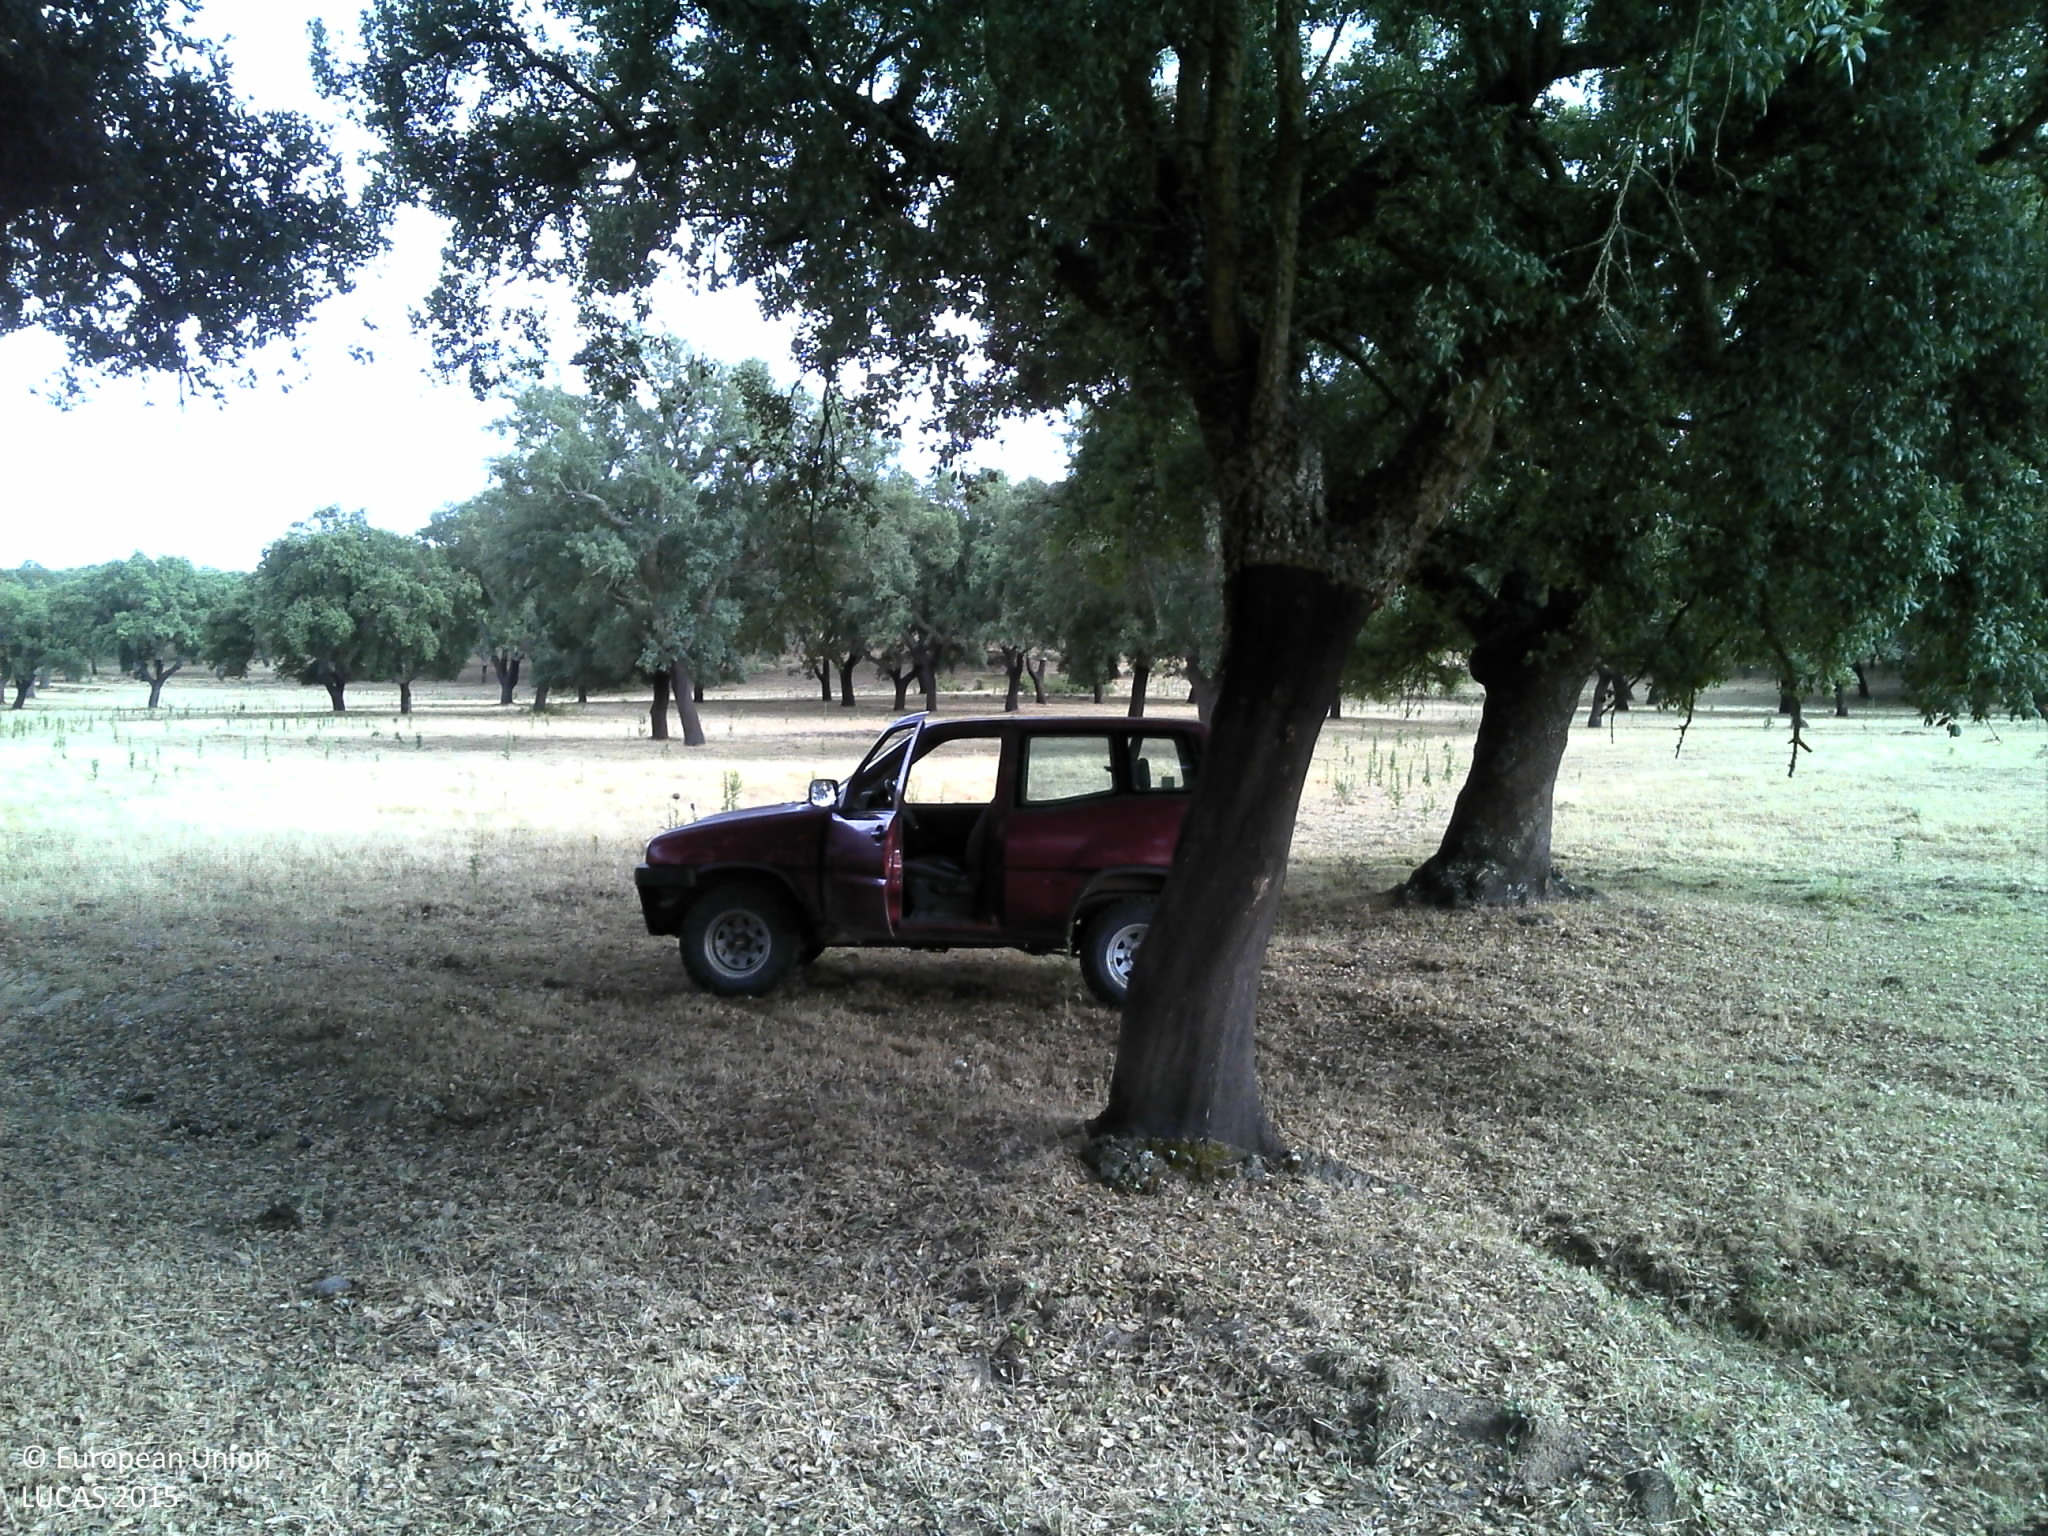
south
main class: Woodland
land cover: Broadleaved woodland
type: broadleaved evergreen forest
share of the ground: 25 - 50 %
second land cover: Grassland without tree/shrub cover
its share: < 10 %
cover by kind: unconsolidated bare surface 50 %, broadleaved forest trees 40 %, herbaceous plants 10 %
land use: Forestry
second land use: Agriculture (excluding fallow land and kitchen gardens)
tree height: > 5 m
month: June
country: PT
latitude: 38.5773
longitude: -8.1474
